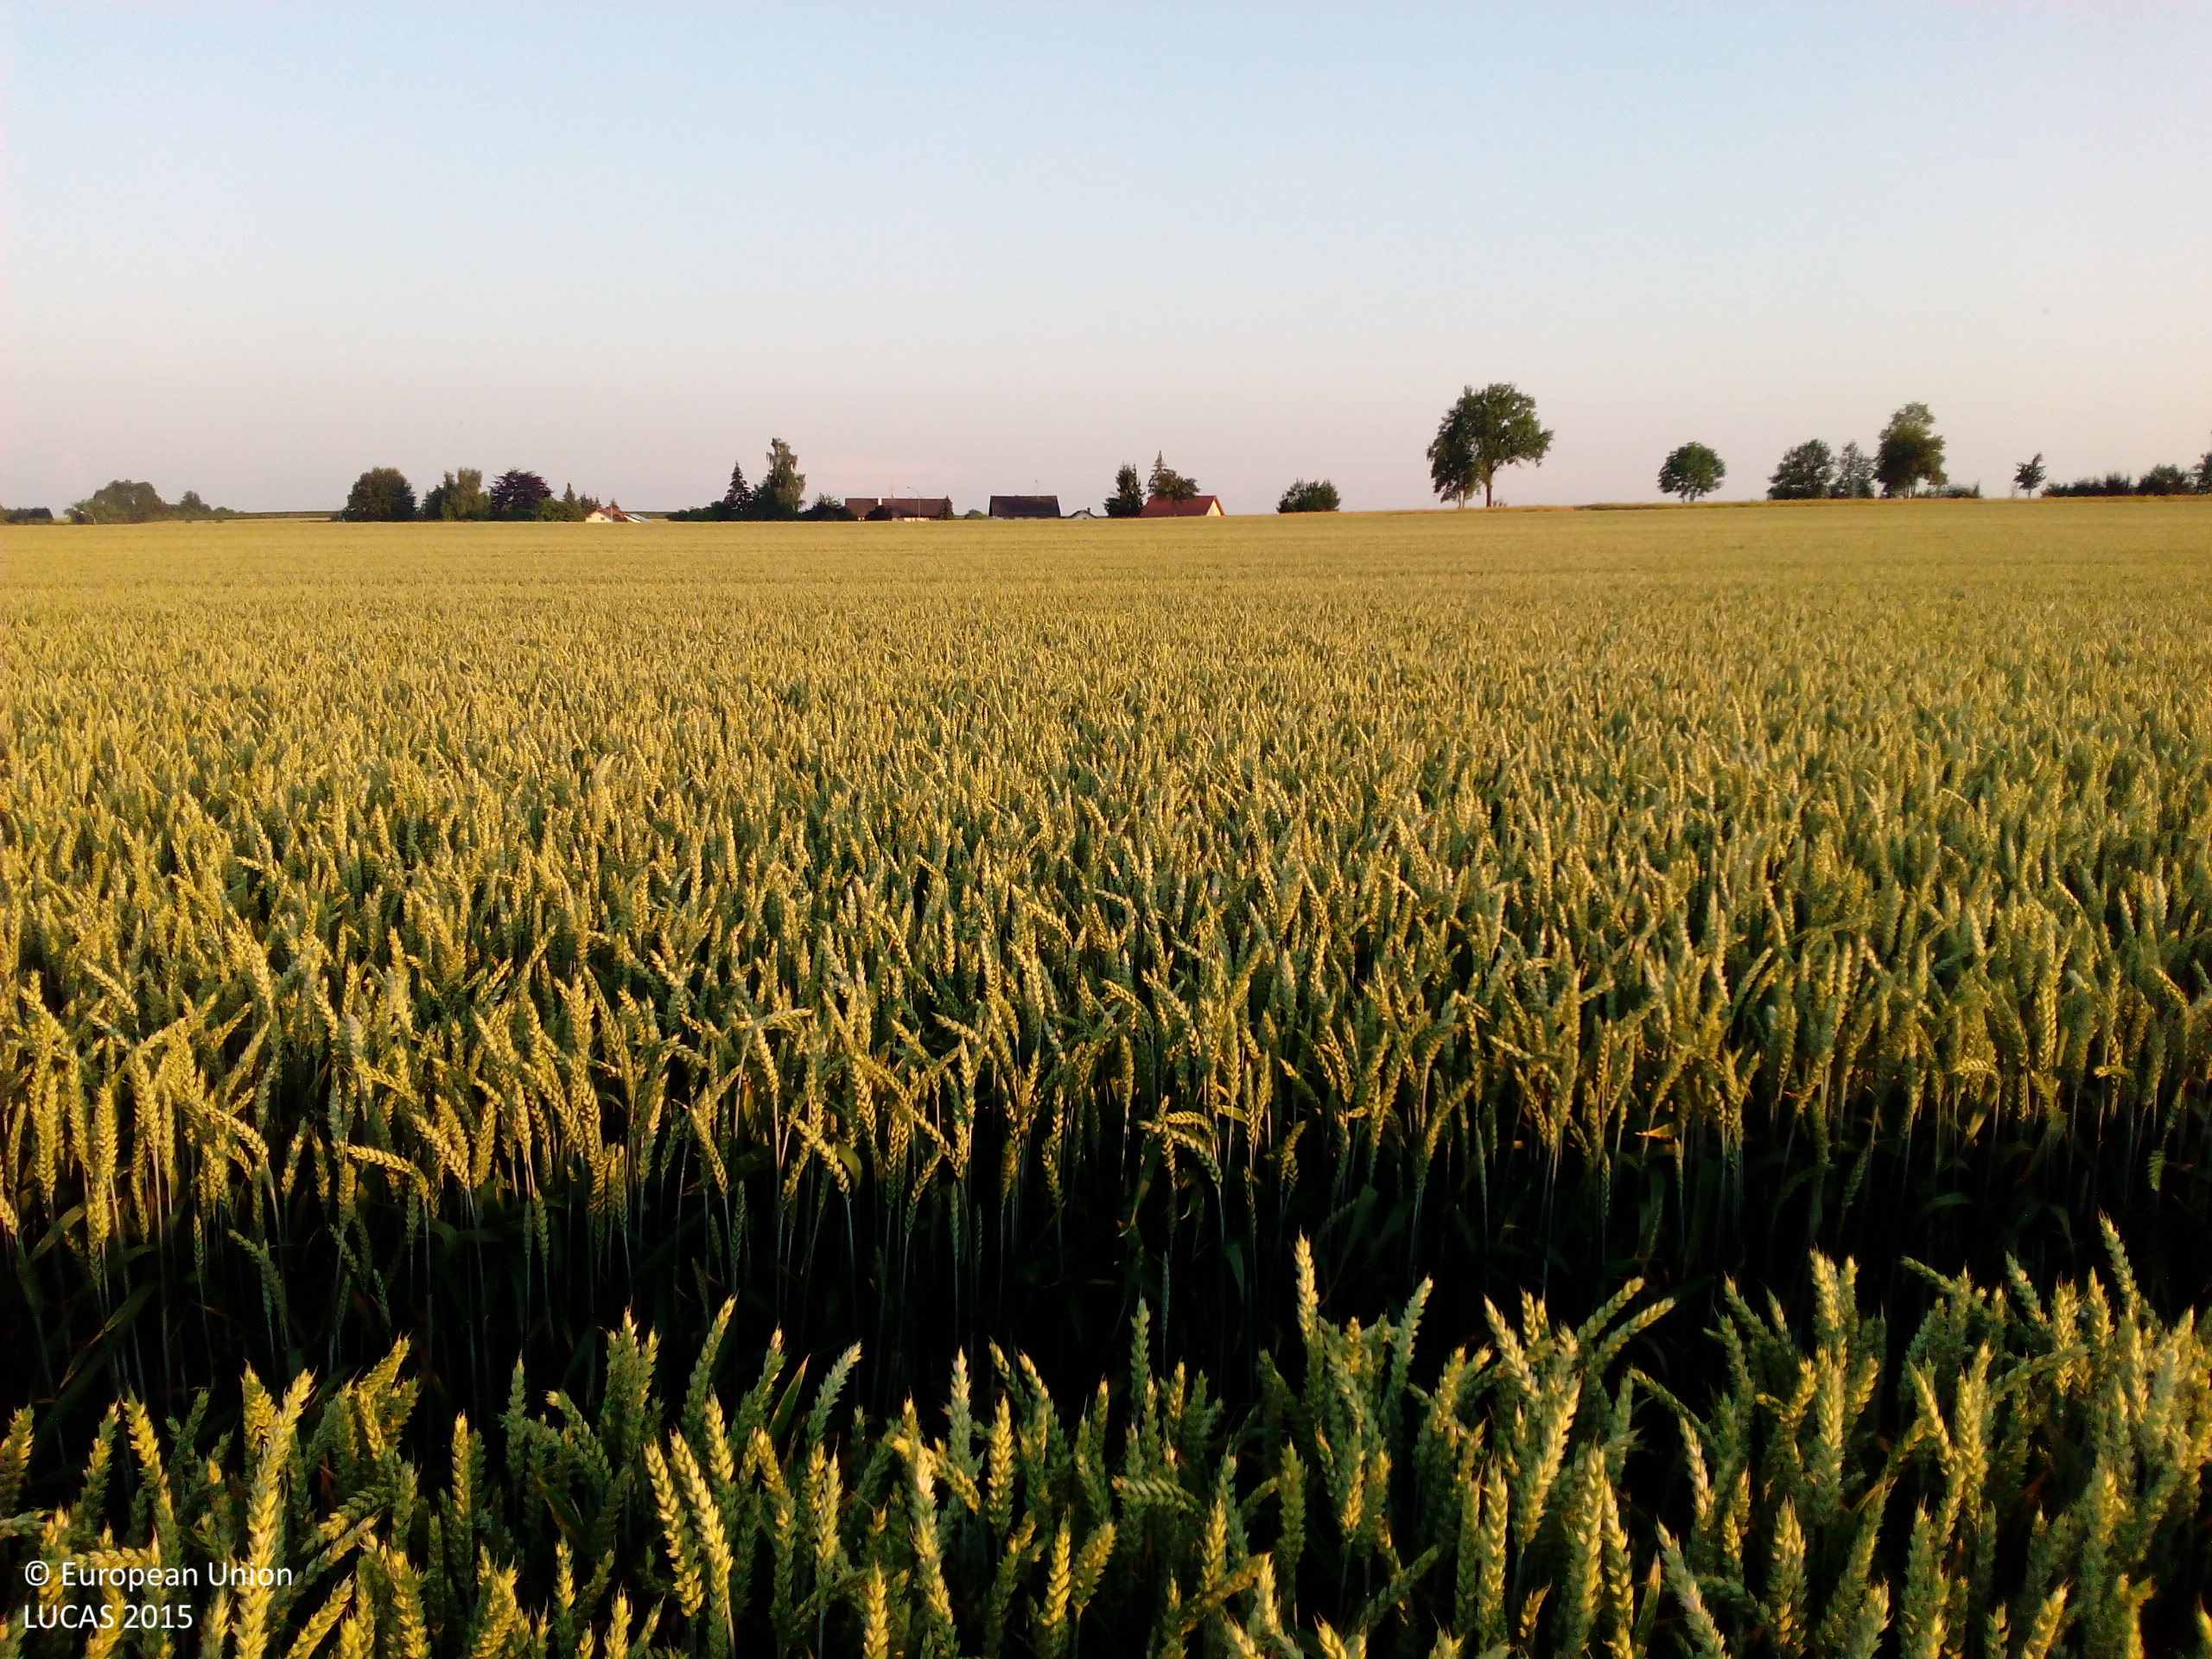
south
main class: Cropland
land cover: Common wheat
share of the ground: > 75 %
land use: Agriculture (excluding fallow land and kitchen gardens)
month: July
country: DE
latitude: 48.7422
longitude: 12.9503
